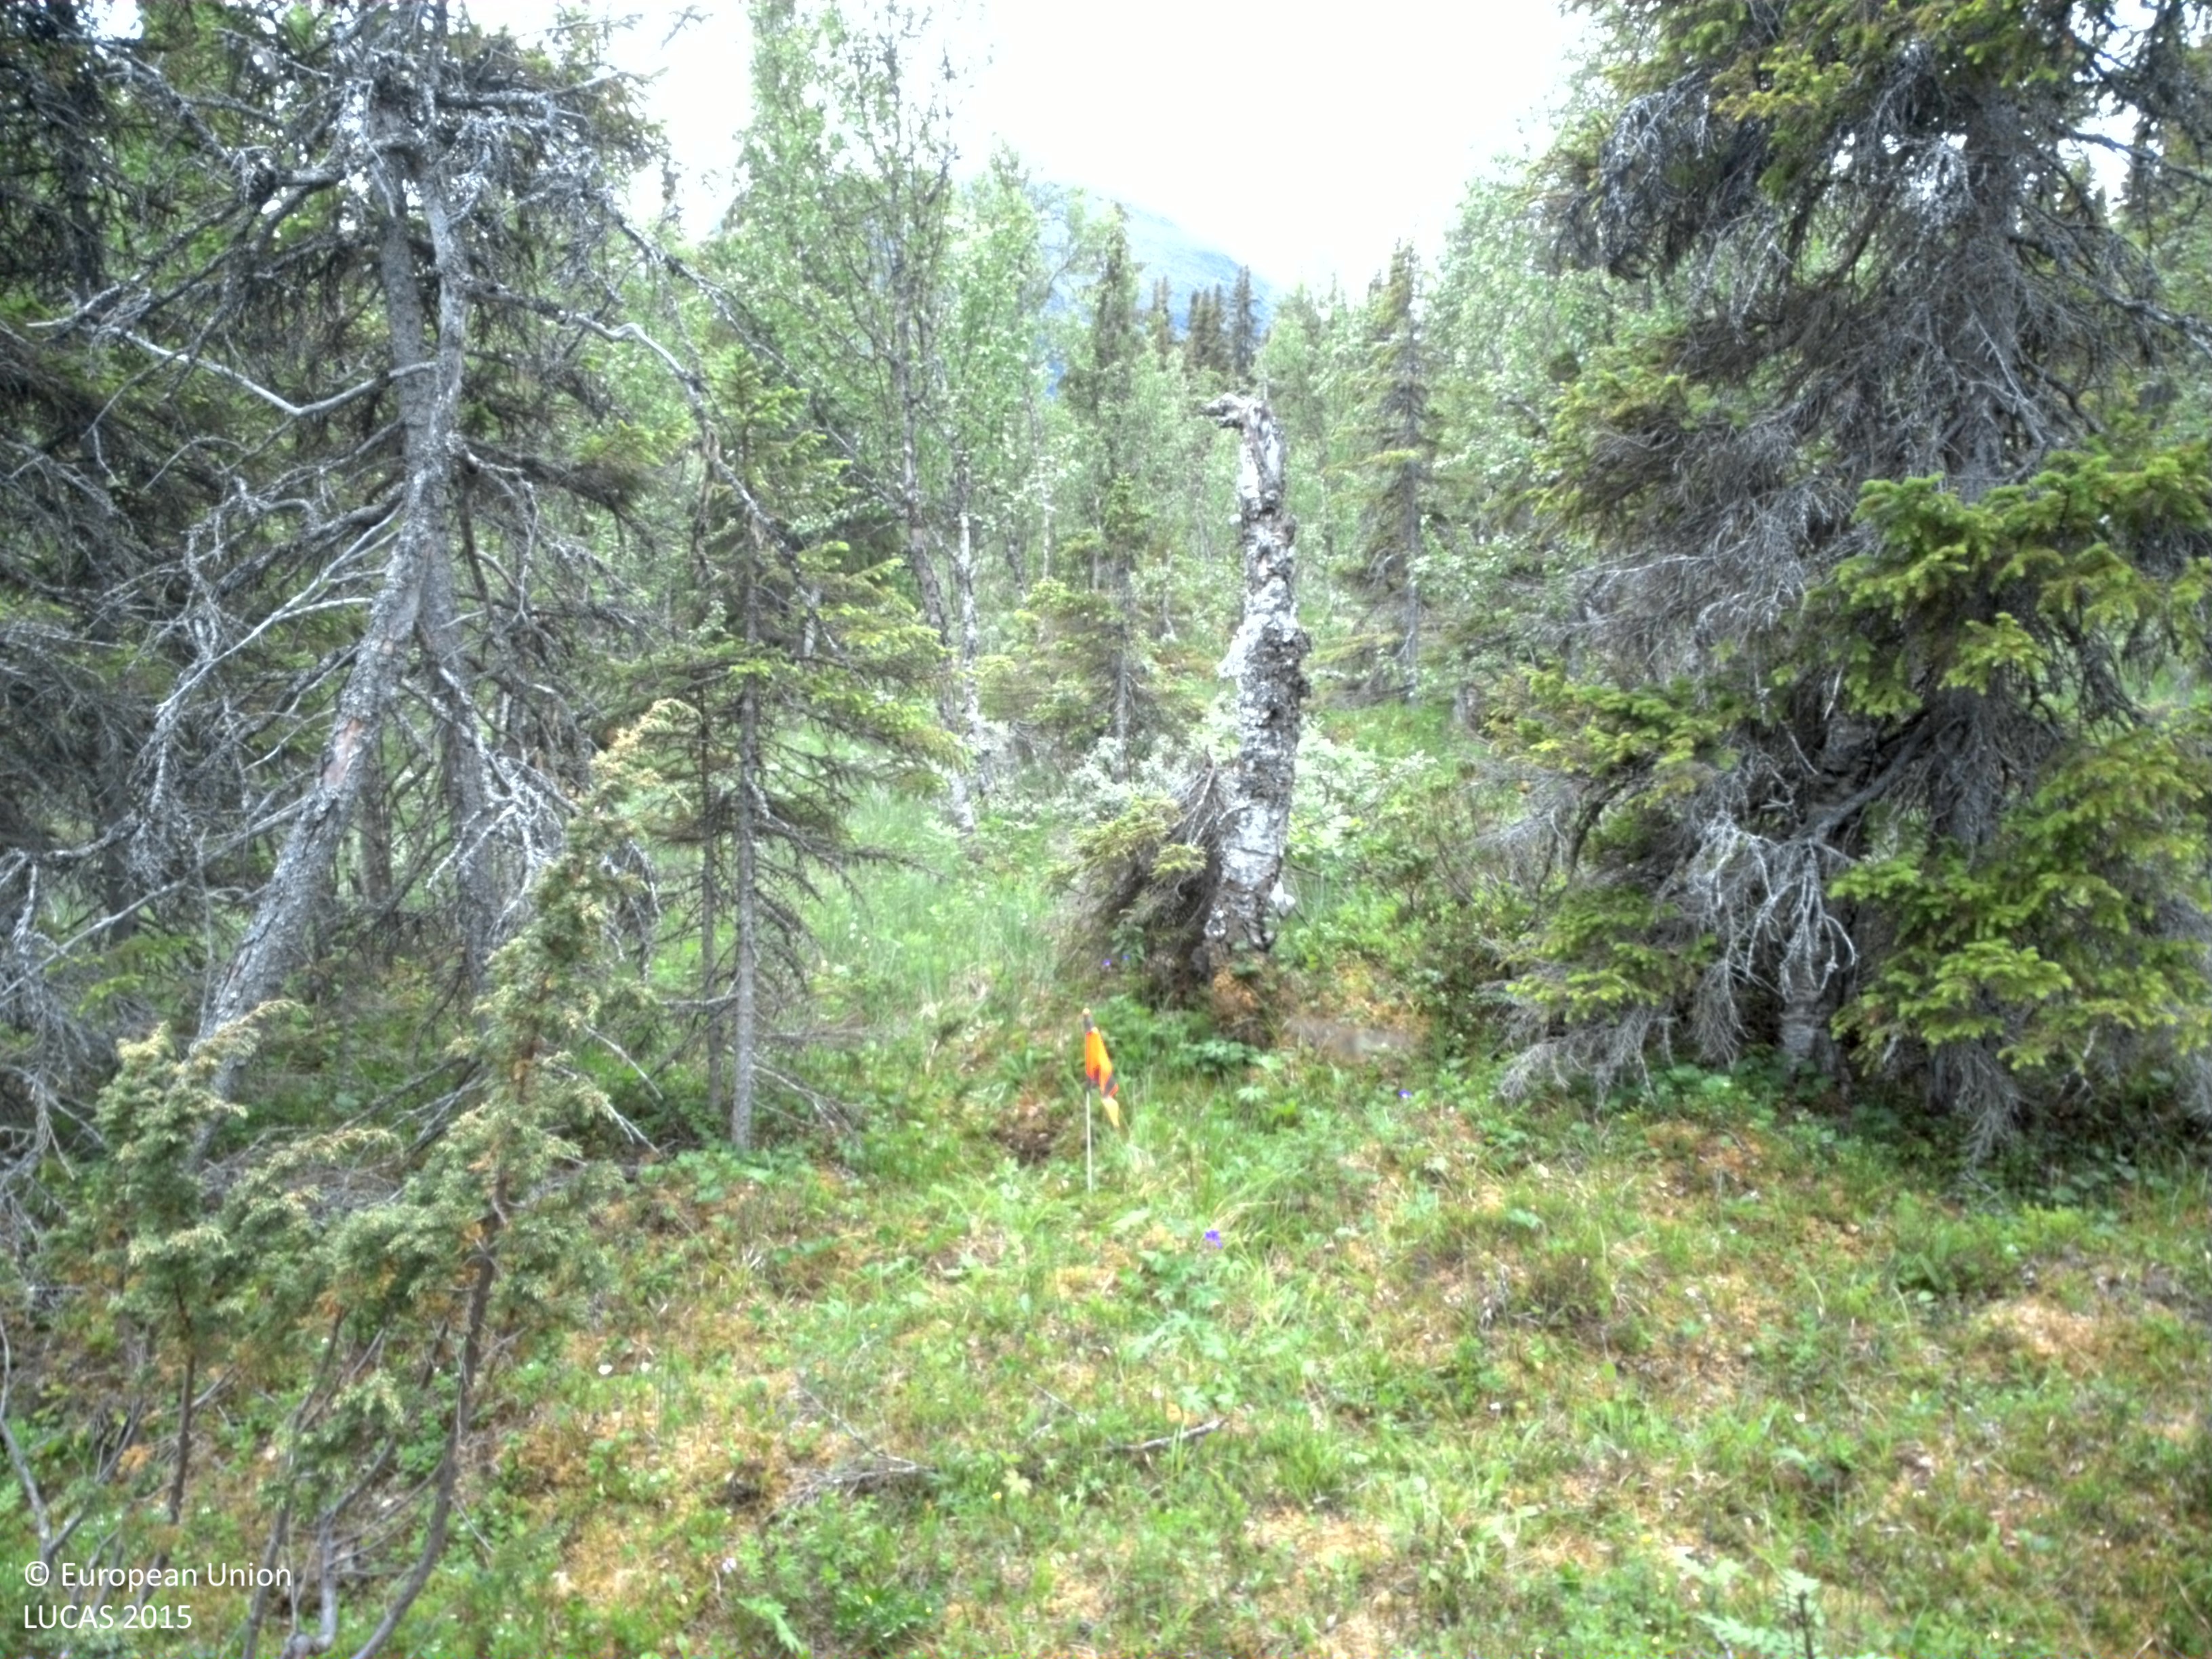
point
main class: Woodland
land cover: Spruce dominated mixed woodland
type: boreal forest
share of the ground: 25 - 50 %
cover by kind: herbaceous plants 35 %, shrubs 30 %, coniferous forest trees 15 %, broadleaved forest trees 10 %, lichens and mosses 10 %
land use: Semi-natural and natural areas not in use
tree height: > 5 m
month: July
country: SE
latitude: 65.6748
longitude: 15.6416
